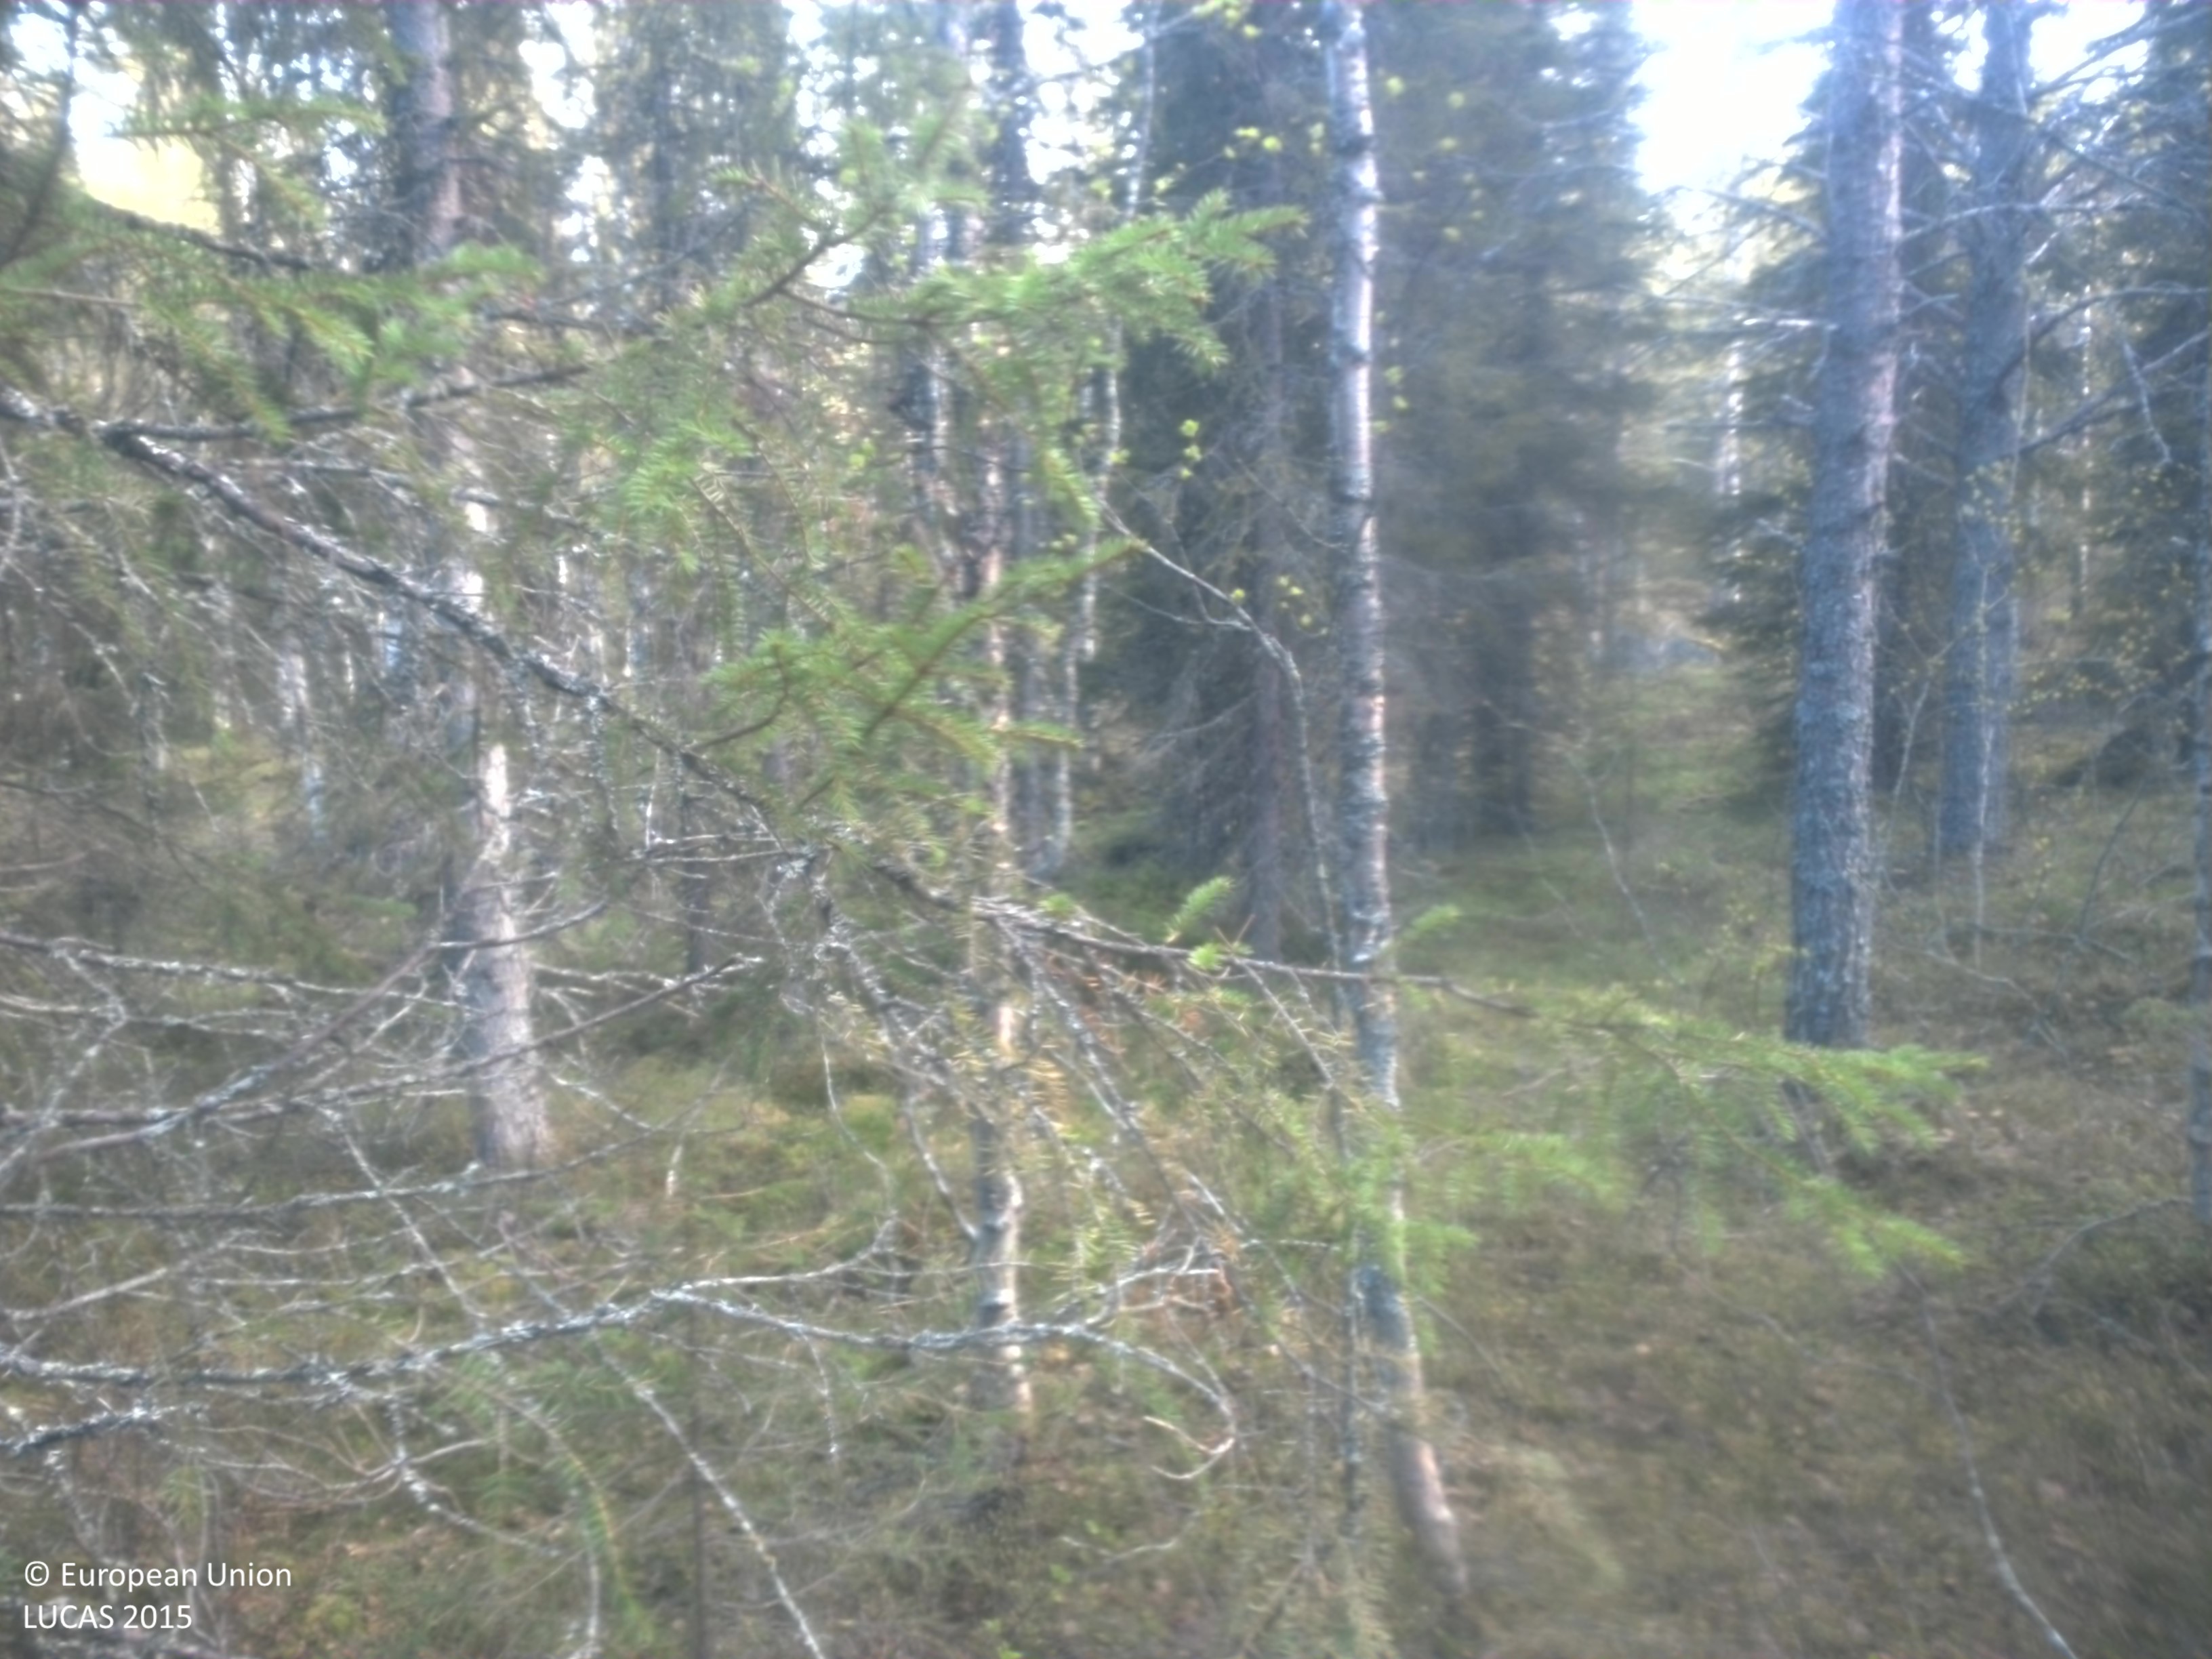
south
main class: Woodland
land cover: Spruce dominated mixed woodland
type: boreal forest
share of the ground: 25 - 50 %
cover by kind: coniferous forest trees 35 %, herbaceous plants 20 %, lichens and mosses 20 %, broadleaved forest trees 15 %, shrubs 5 %
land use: Forestry
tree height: > 5 m
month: June
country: SE
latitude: 64.4622
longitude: 17.7638
